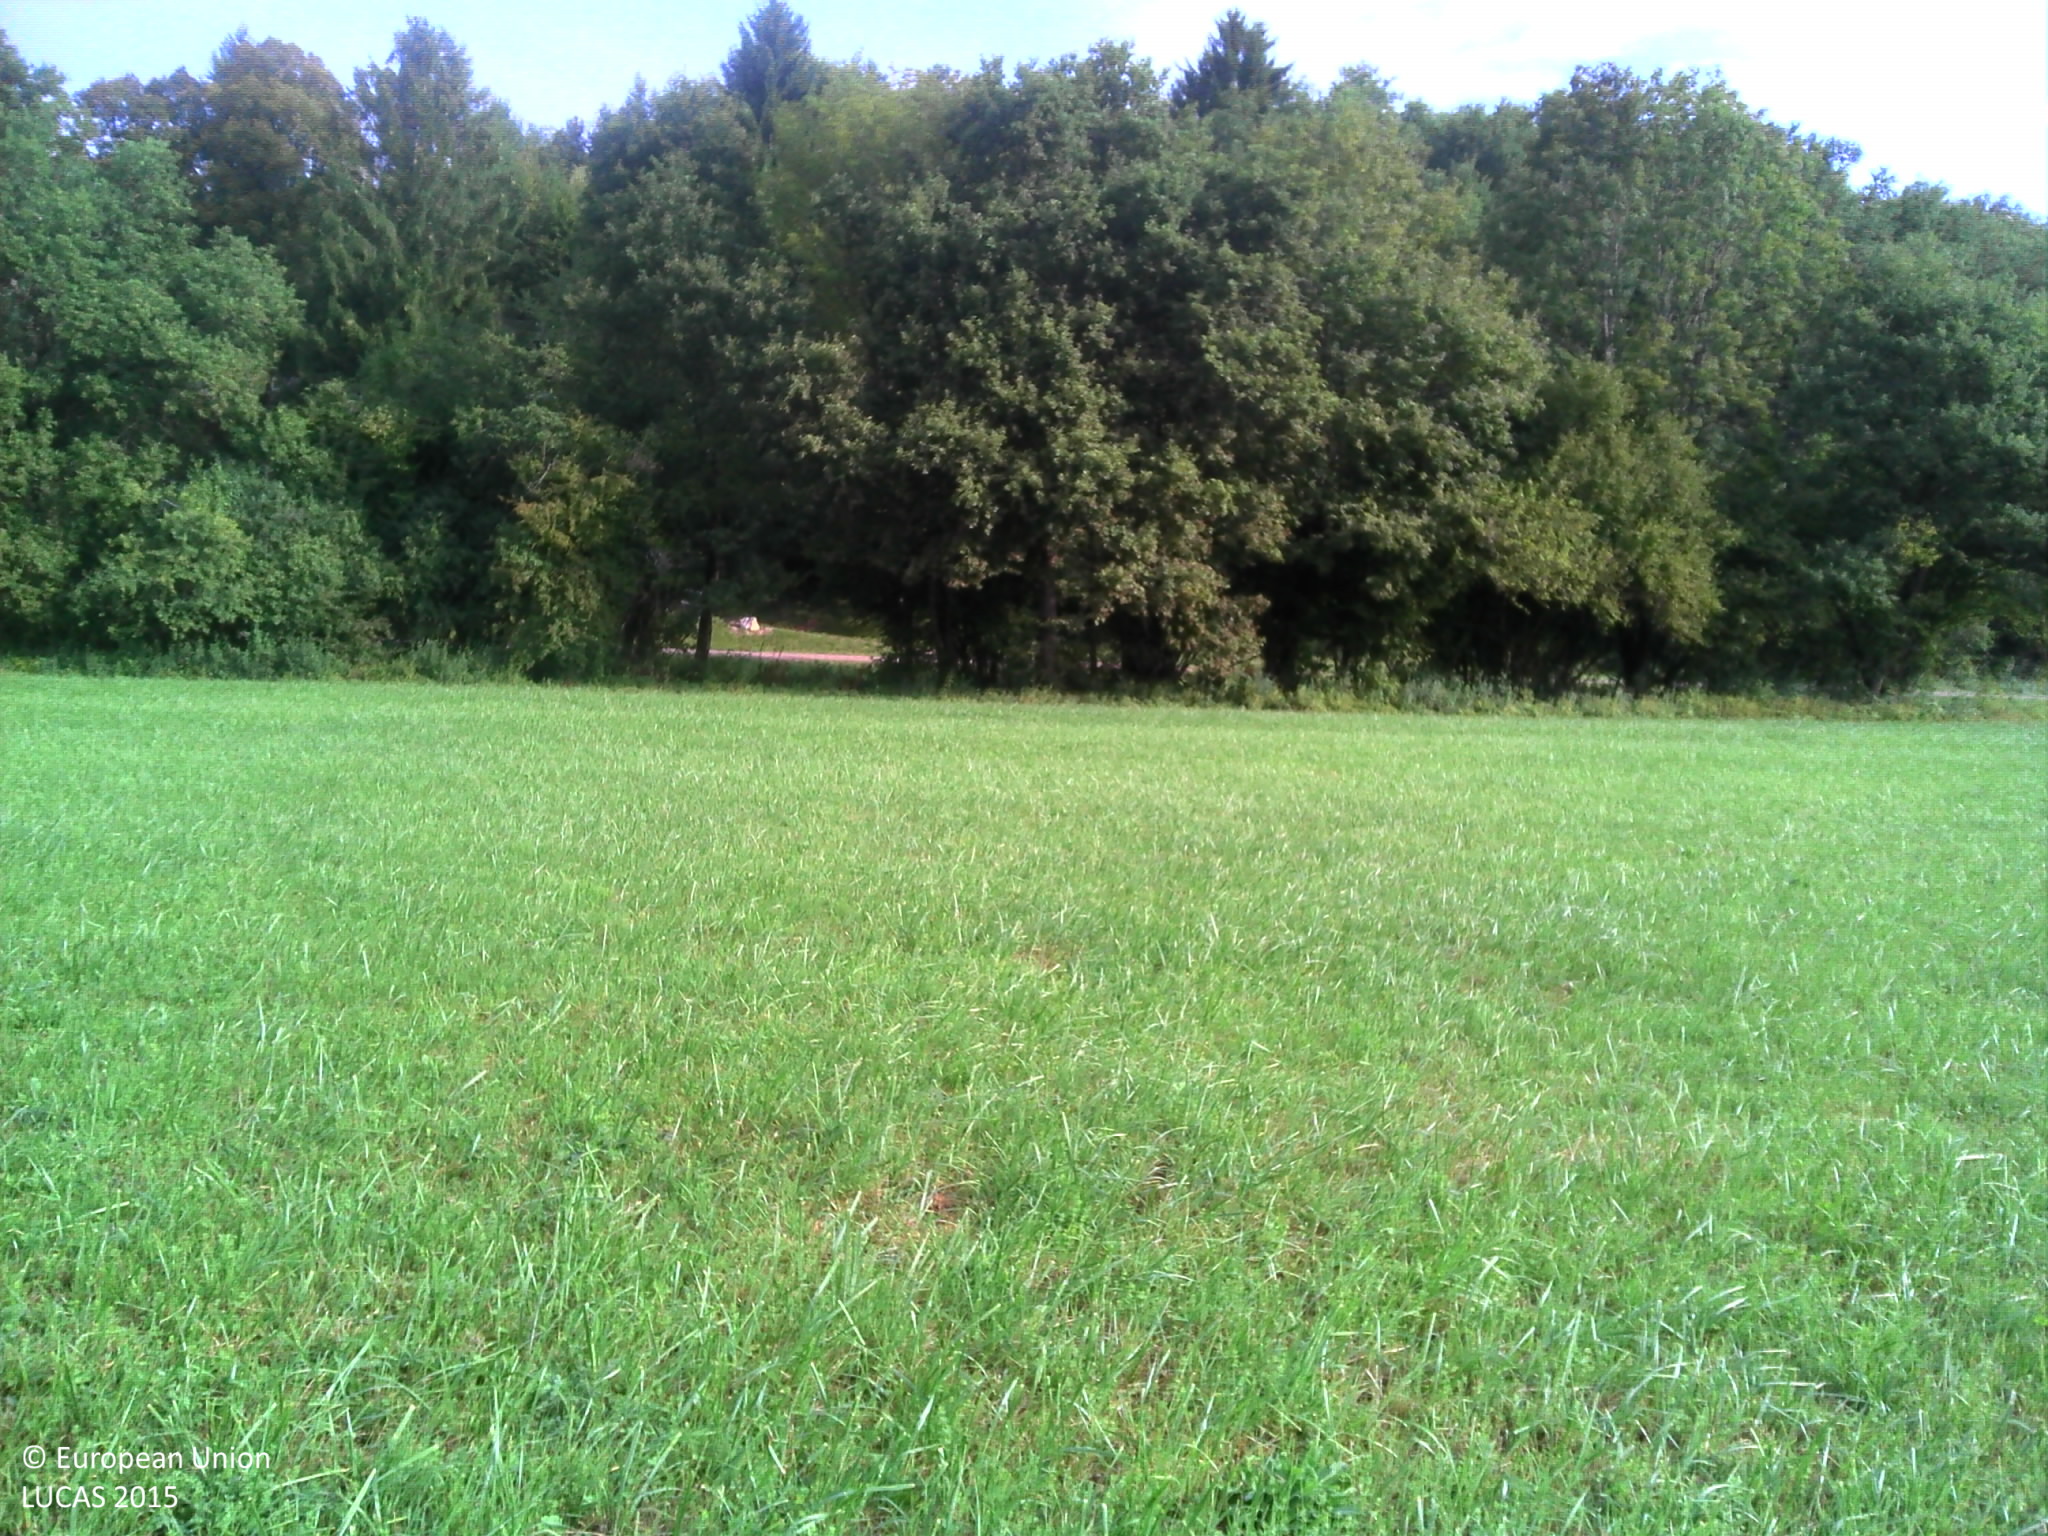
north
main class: Grassland
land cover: Grassland without tree/shrub cover
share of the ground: > 75 %
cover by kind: herbaceous plants 100 %
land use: Agriculture (excluding fallow land and kitchen gardens)
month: September
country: FR
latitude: 47.4332
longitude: 6.6208
